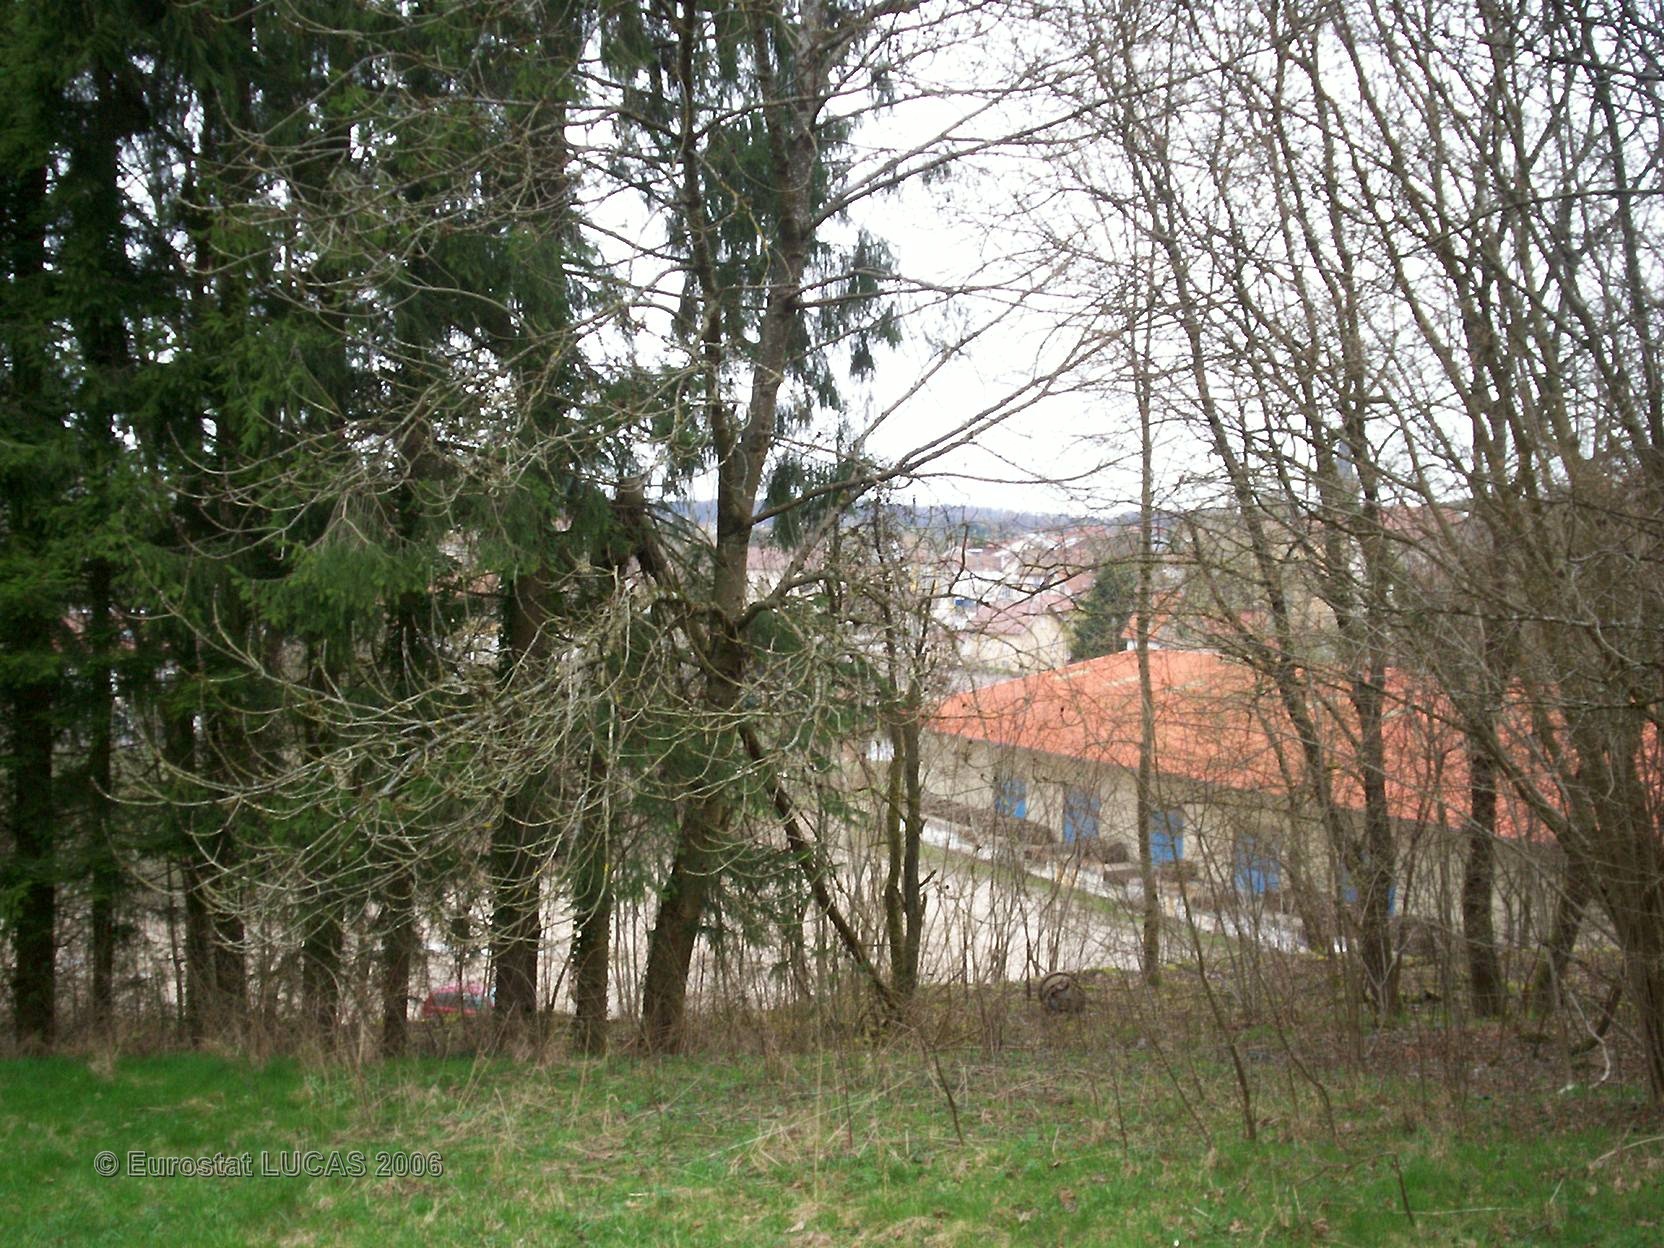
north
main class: Grassland
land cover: Grassland without tree/shrub cover
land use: Agriculture (excluding fallow land and kitchen gardens)
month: April
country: FR
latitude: 47.9981
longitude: 6.2616
